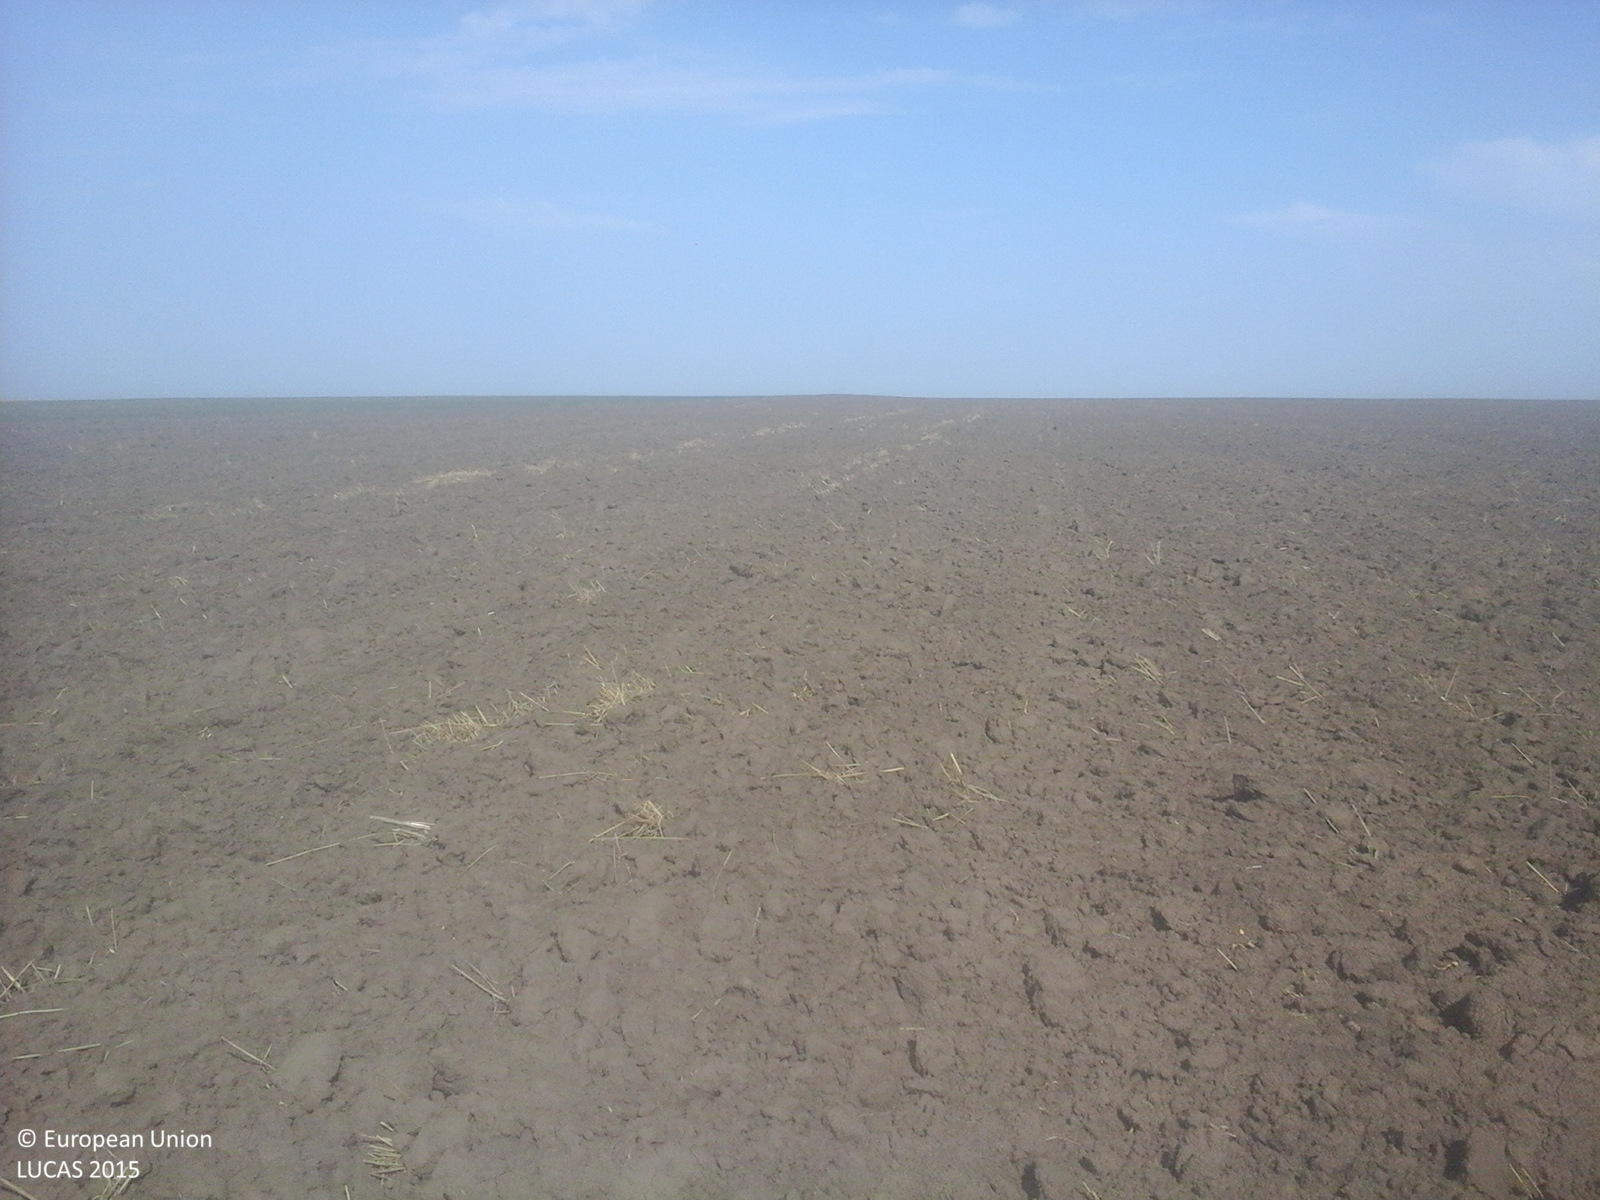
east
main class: Cropland
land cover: Common wheat
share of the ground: < 10 %
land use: Agriculture (excluding fallow land and kitchen gardens)
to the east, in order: Common wheat
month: August
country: RO
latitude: 43.9536
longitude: 28.2398
